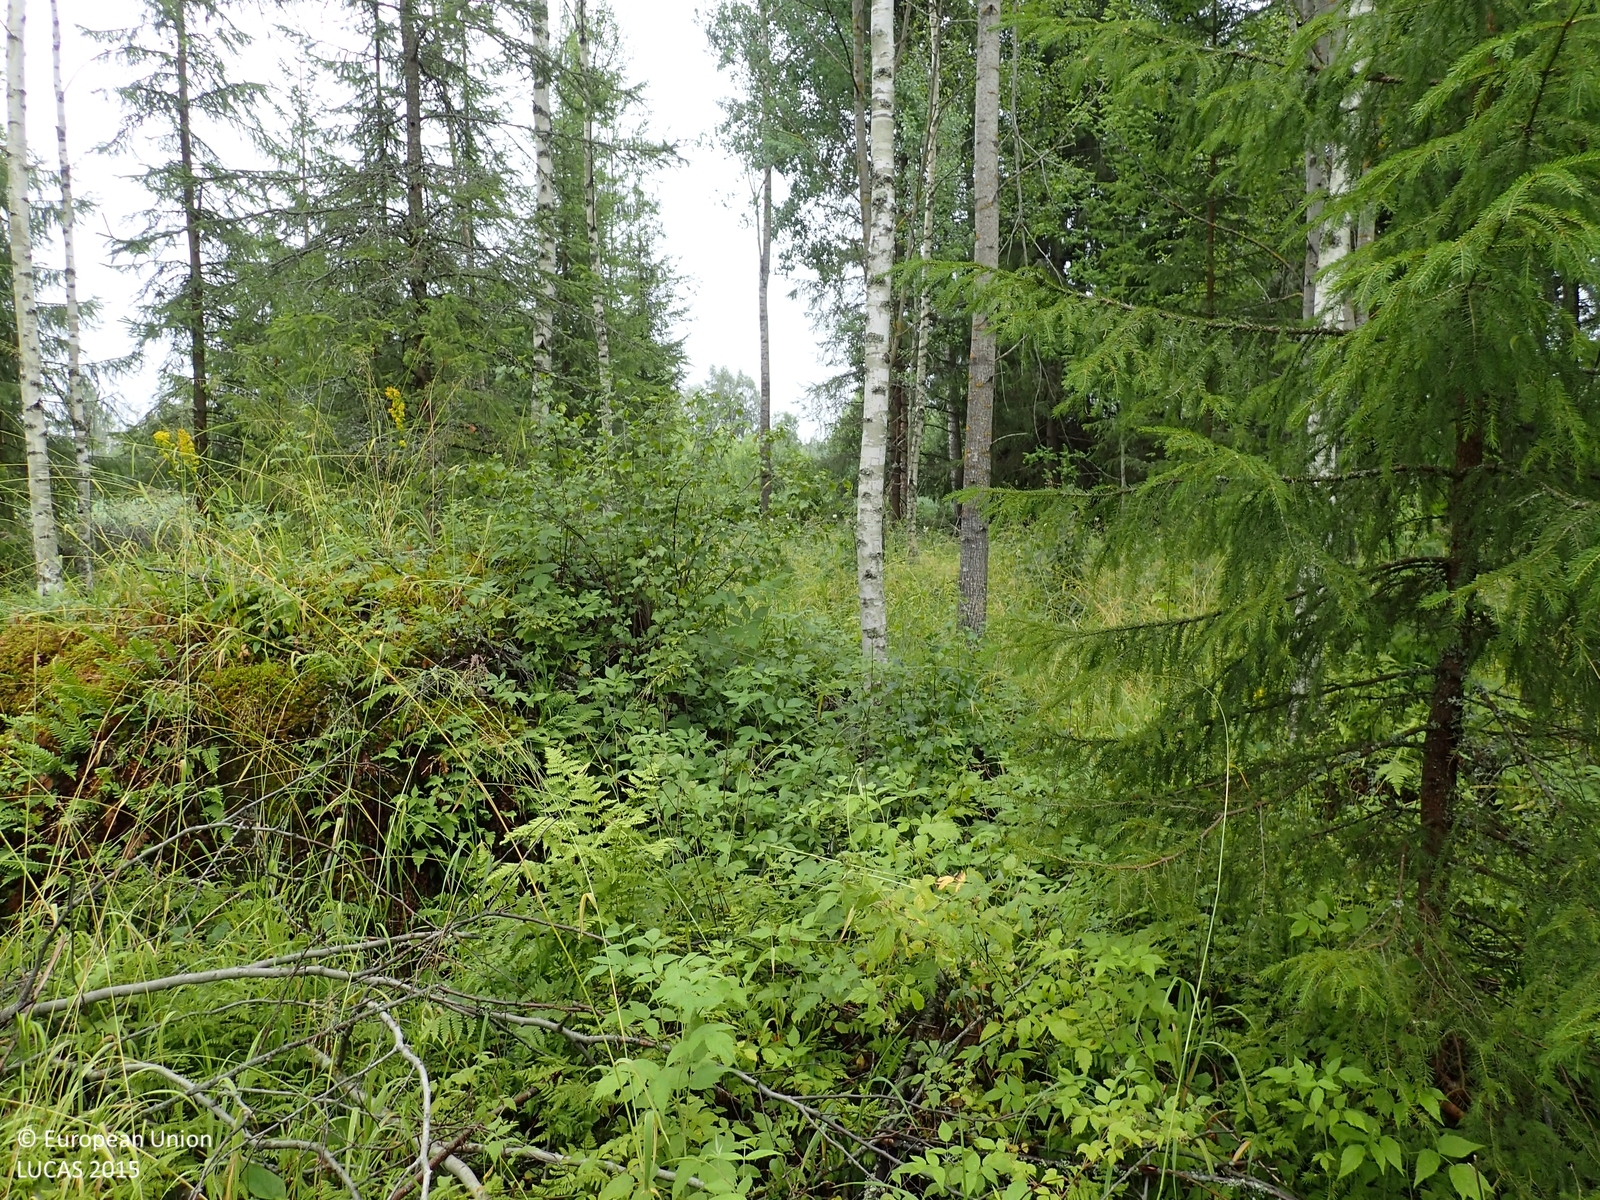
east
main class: Woodland
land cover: Spruce dominated mixed woodland
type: boreal forest
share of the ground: 50 - 75 %
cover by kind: coniferous forest trees 45 %, herbaceous plants 40 %, broadleaved forest trees 15 %
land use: Forestry
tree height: > 5 m
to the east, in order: Spruce dominated mixed woodland; Shruby margins; Ditches and canals; Shruby margins; Oats; Shruby margins; Ditches and canals; Shruby margins; Common wheat; Artificial constructions in urban areas; Shruby margins; Ditches and canals; Shruby margins; Spontaneously vegetated surfaces
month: July
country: FI
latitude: 62.9550
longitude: 22.6509
